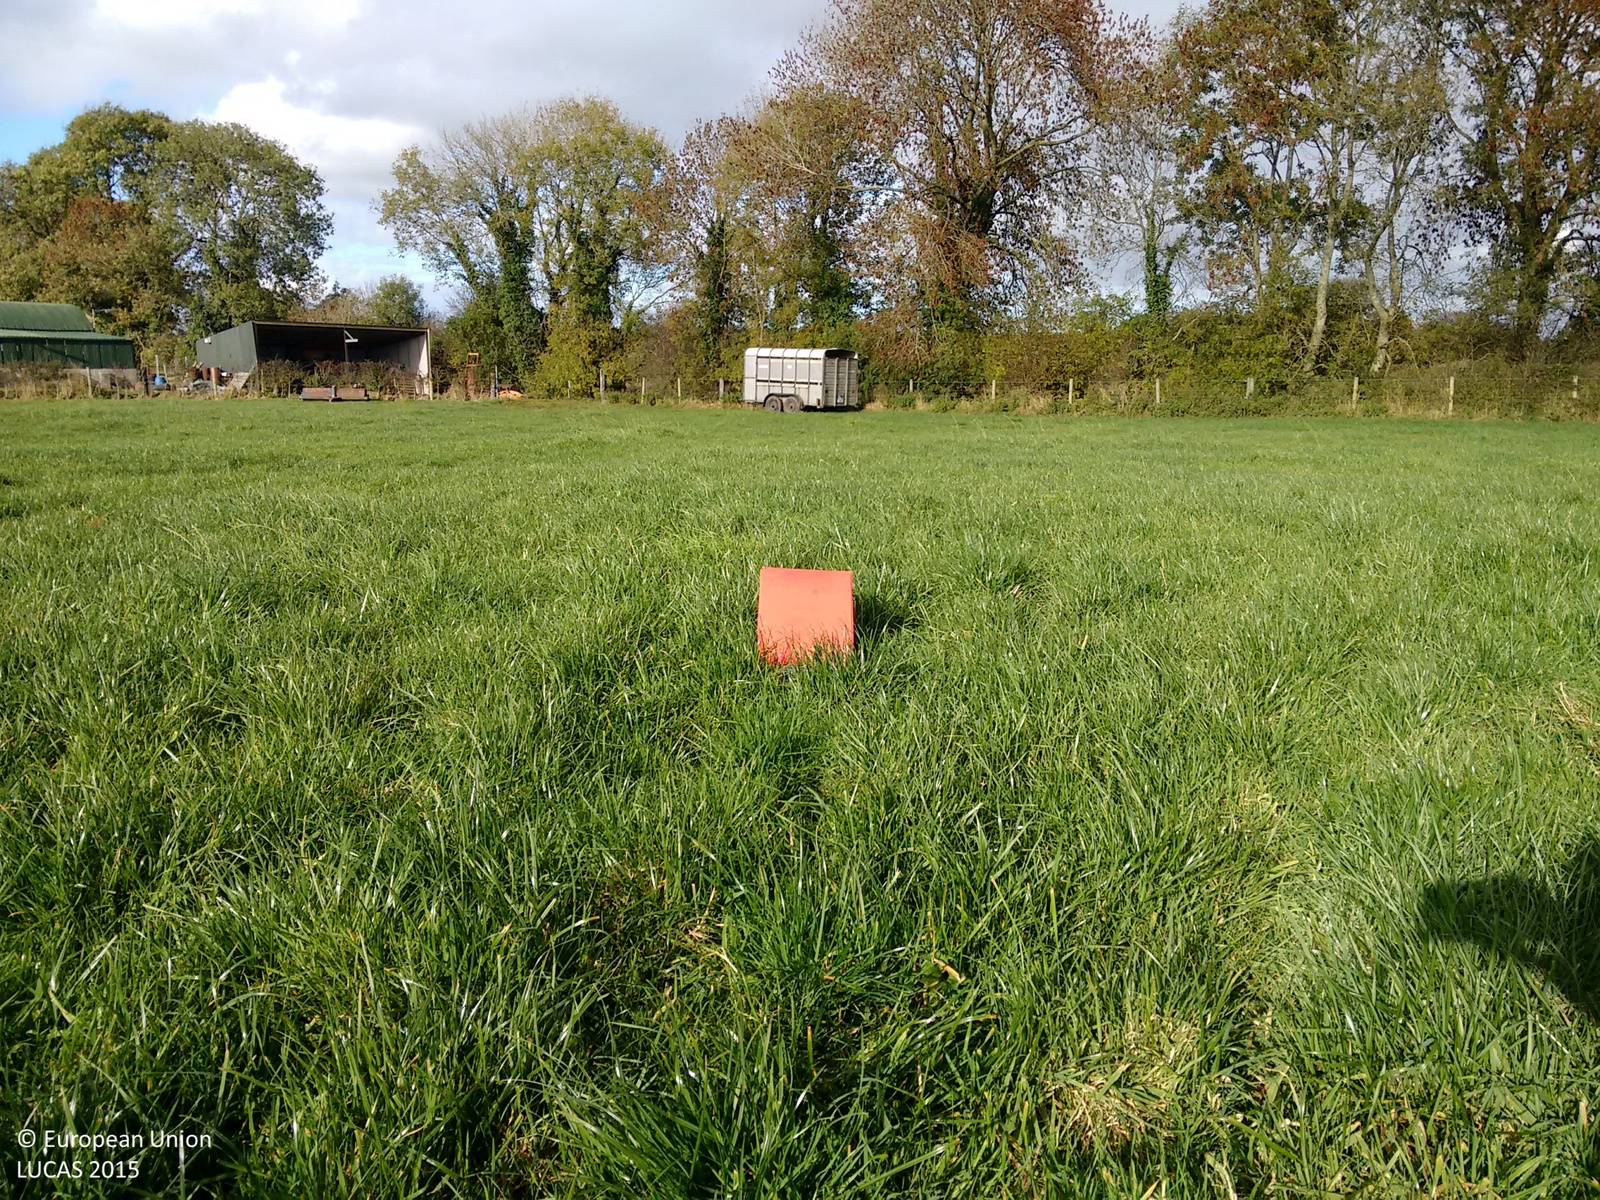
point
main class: Grassland
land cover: Grassland without tree/shrub cover
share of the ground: > 75 %
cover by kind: herbaceous plants 100 %
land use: Agriculture (excluding fallow land and kitchen gardens)
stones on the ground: < 10 %
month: October
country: IE
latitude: 53.2725
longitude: -7.7564
